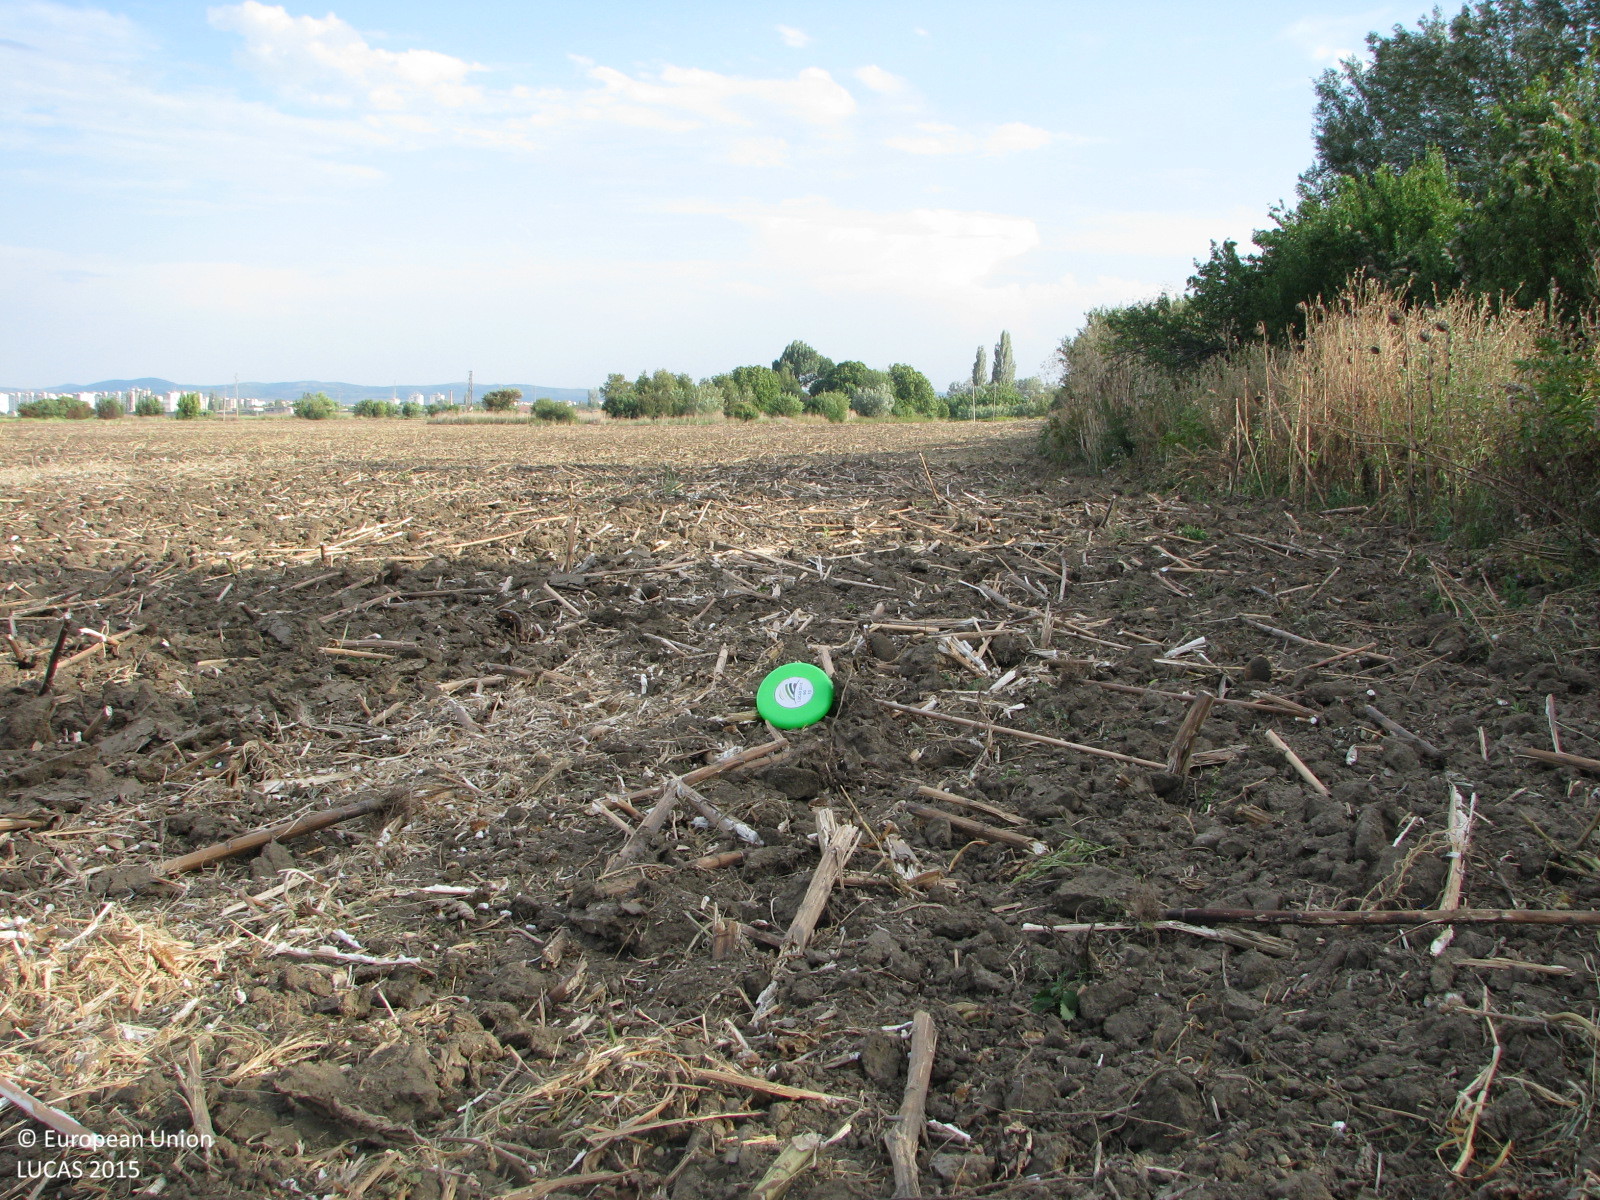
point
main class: Cropland
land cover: Sunflower
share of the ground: < 10 %
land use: Agriculture (excluding fallow land and kitchen gardens)
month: September
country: BG
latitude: 42.5135
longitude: 25.9884
